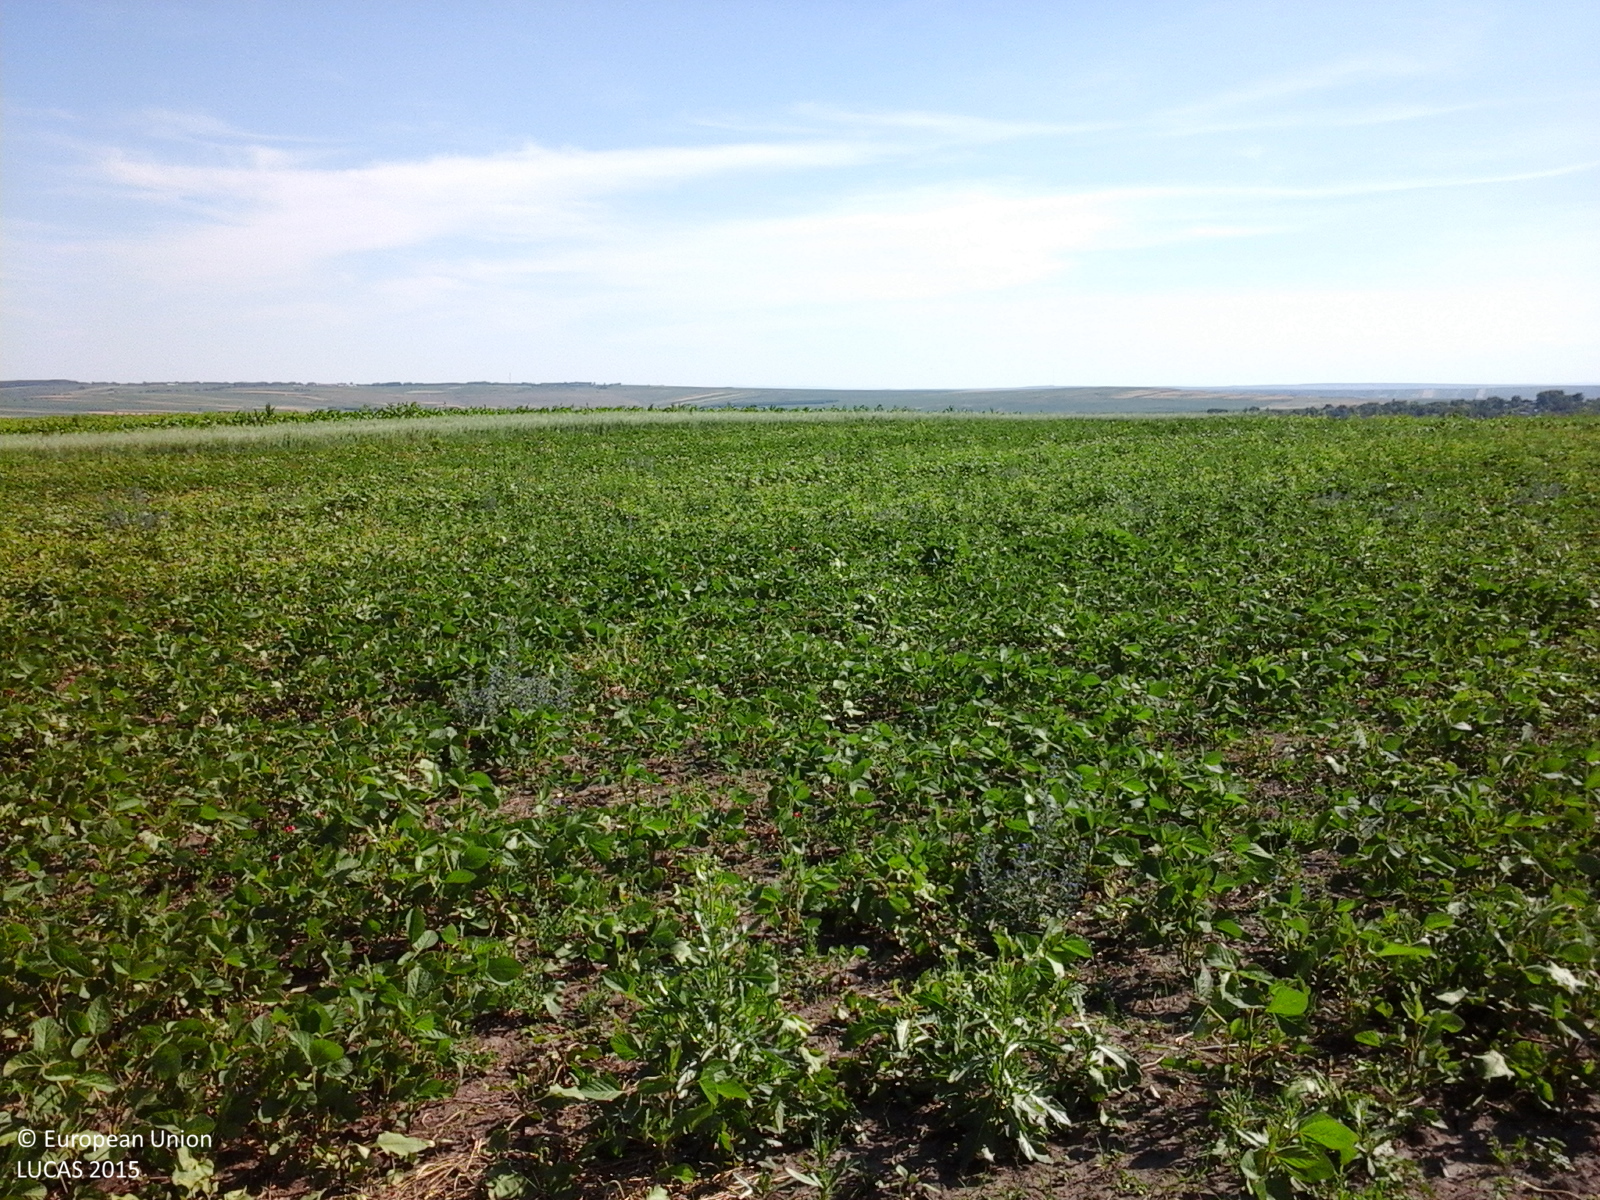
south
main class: Cropland
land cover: Soya
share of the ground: > 75 %
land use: Agriculture (excluding fallow land and kitchen gardens)
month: June
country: RO
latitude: 48.0747
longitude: 26.9499
